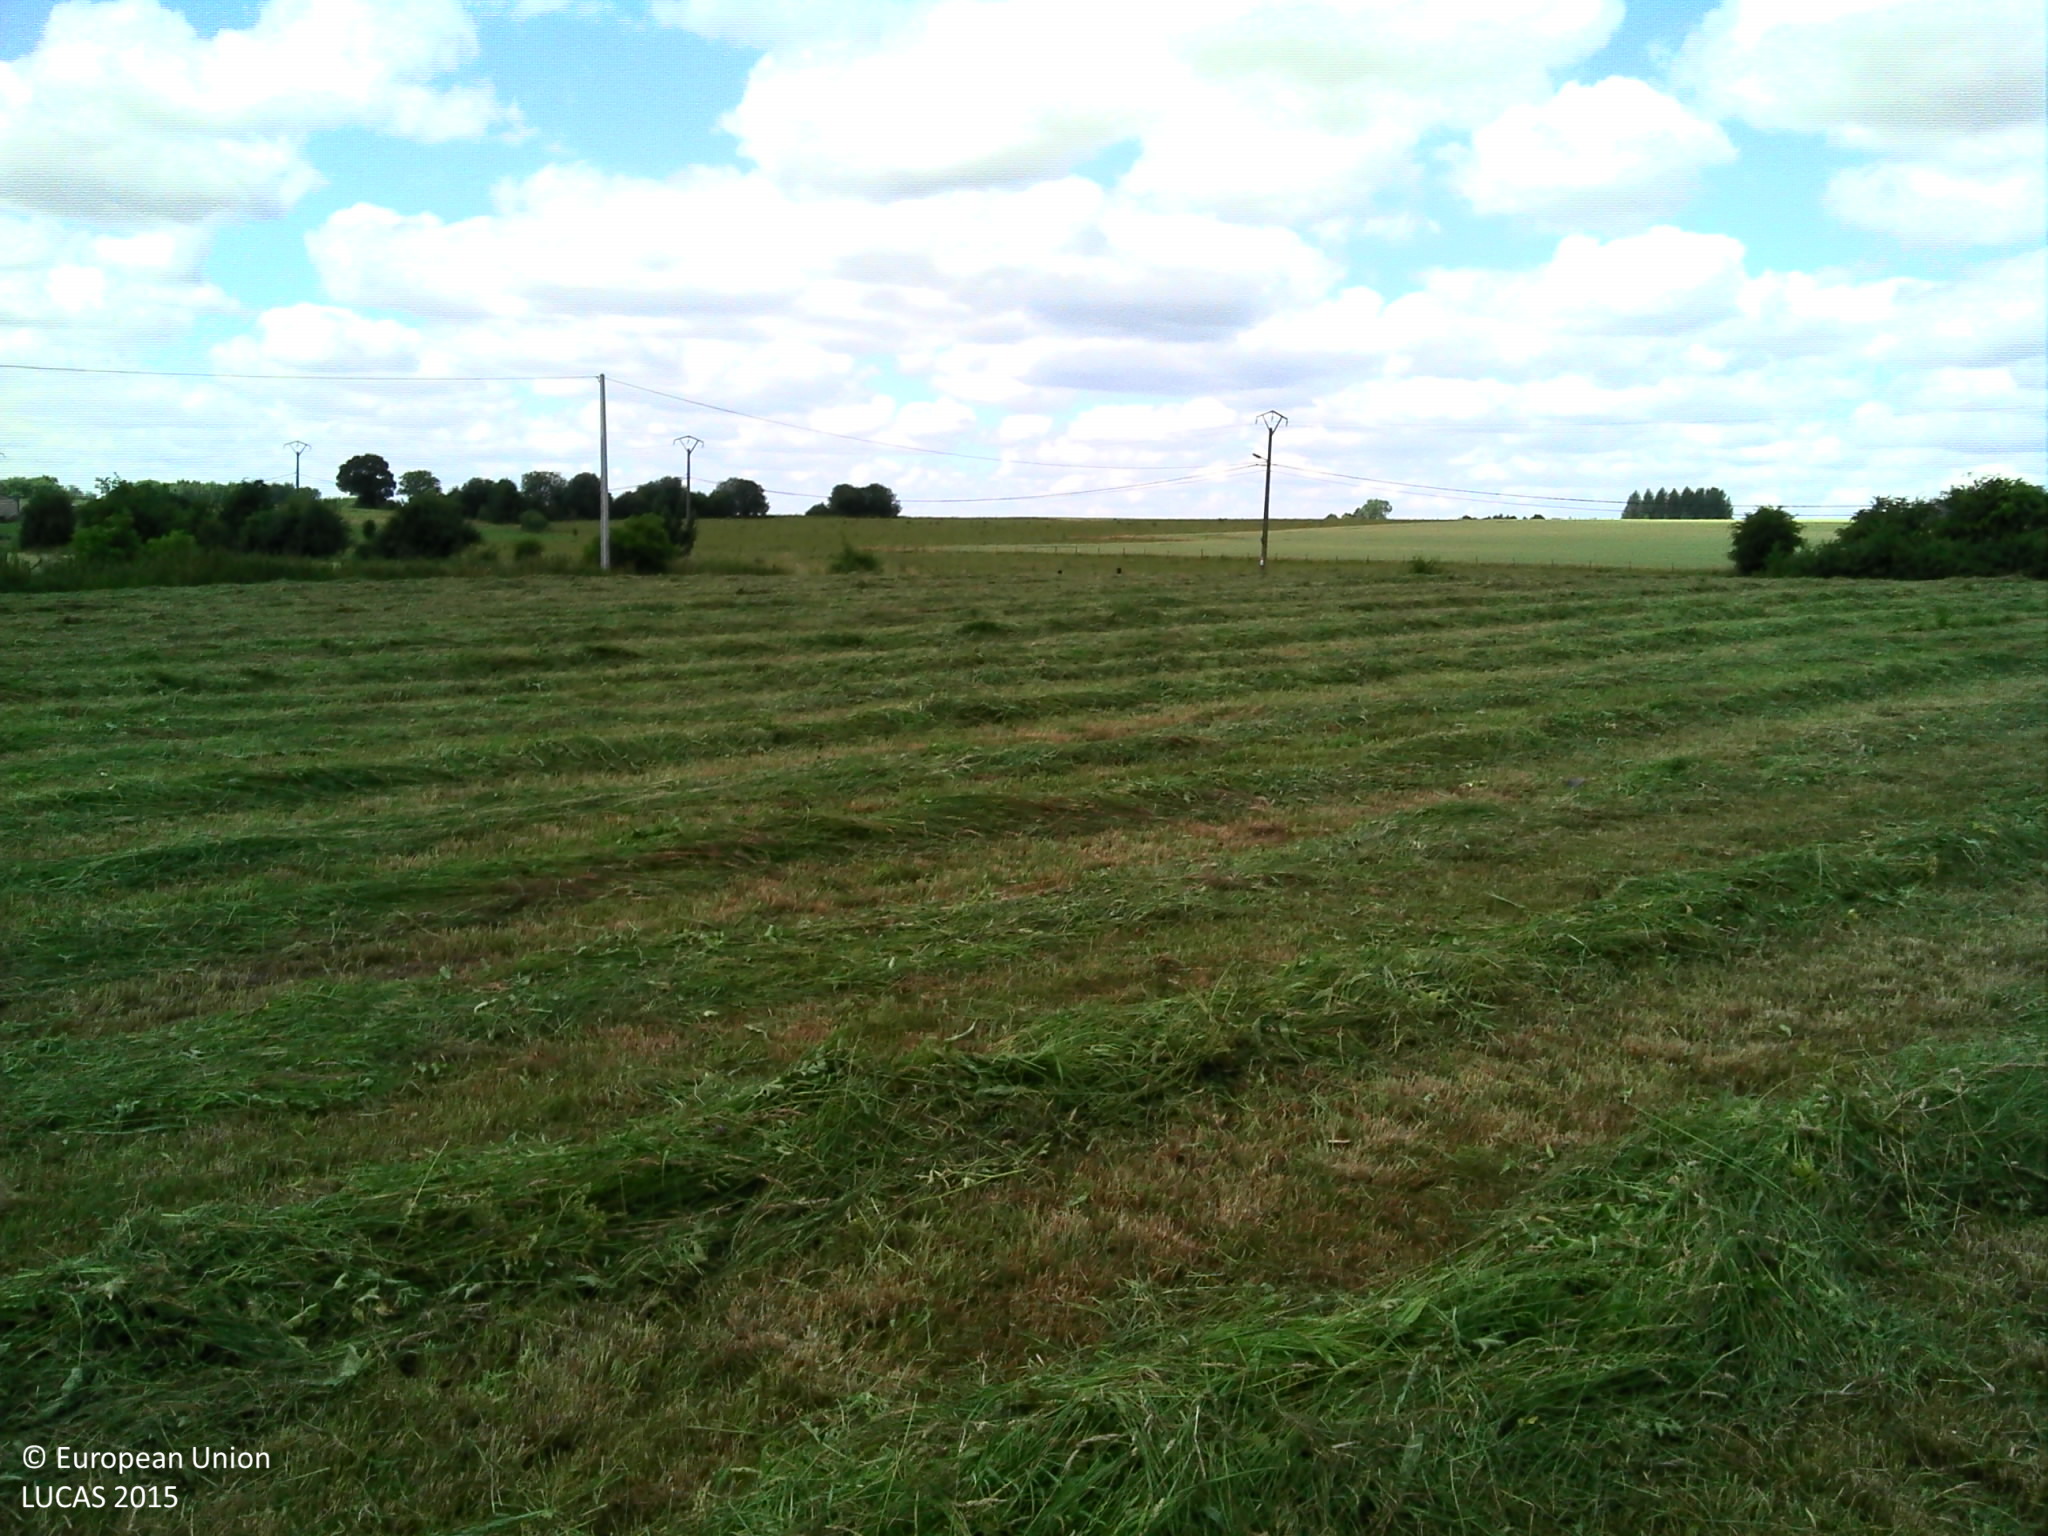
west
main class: Grassland
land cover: Grassland without tree/shrub cover
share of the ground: > 75 %
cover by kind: herbaceous plants 100 %
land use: Agriculture (excluding fallow land and kitchen gardens)
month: July
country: BE
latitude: 50.2557
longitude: 4.6243
